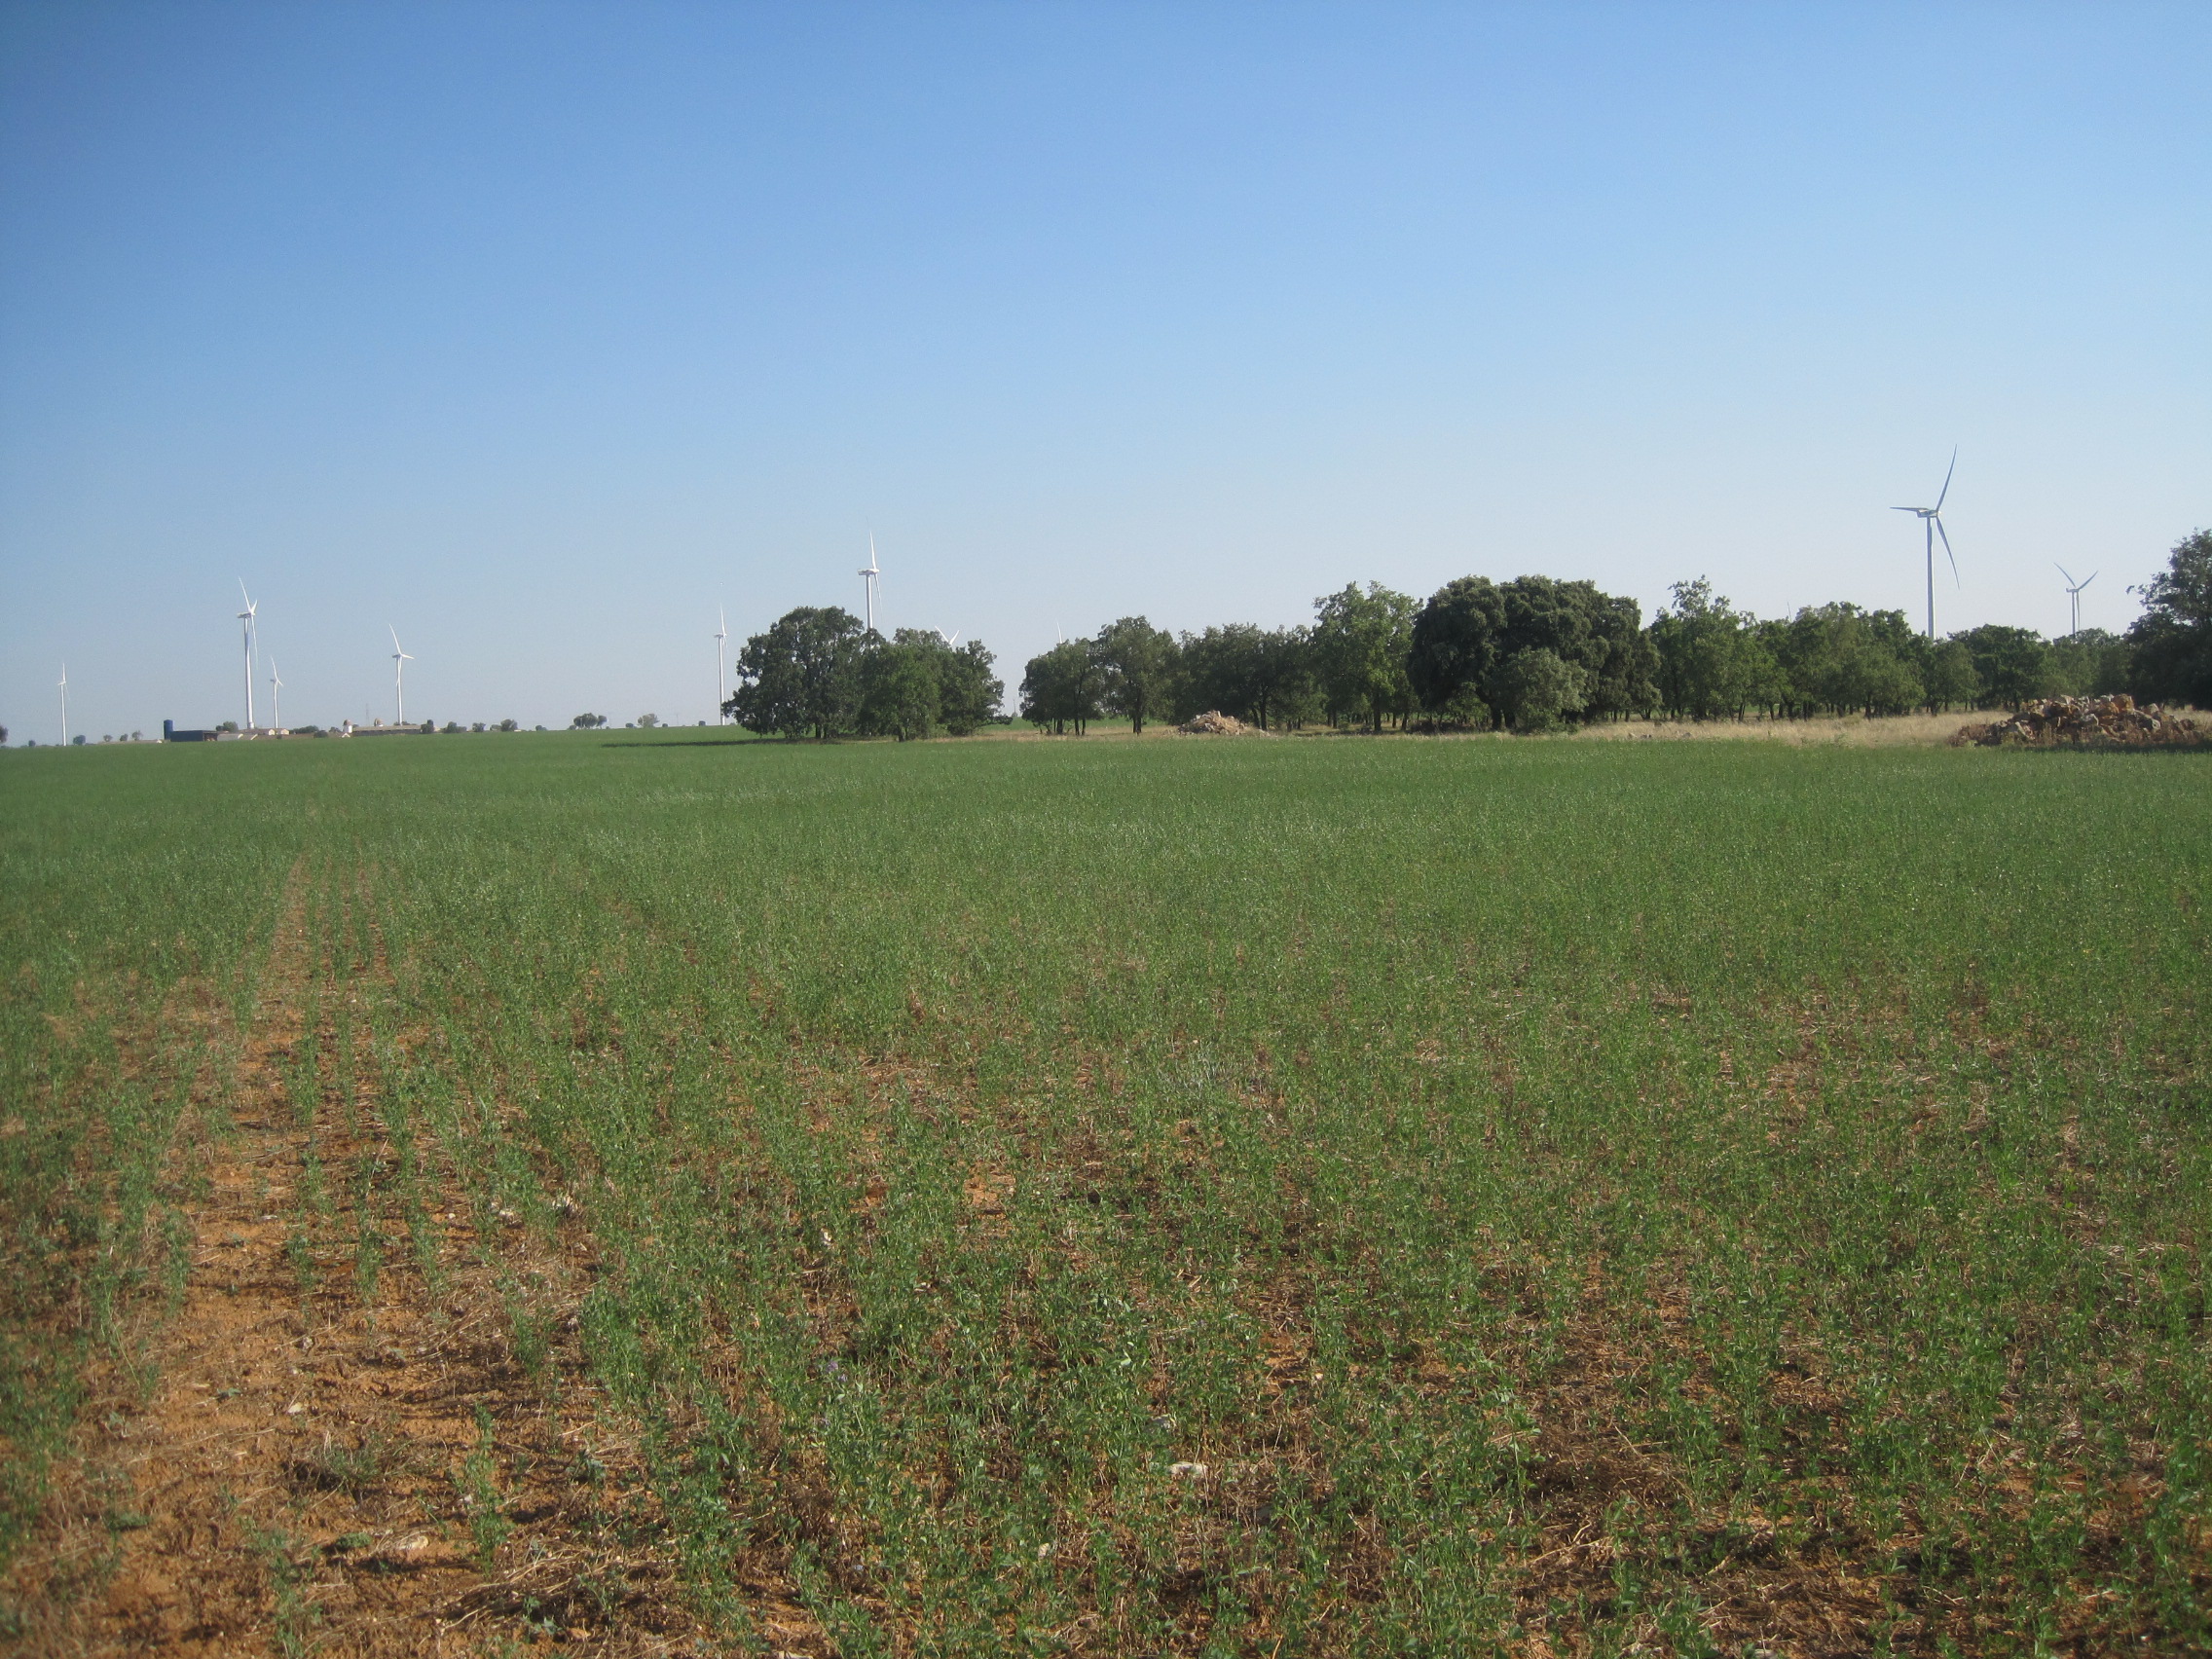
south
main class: Cropland
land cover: Lucerne
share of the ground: > 75 %
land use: Agriculture (excluding fallow land and kitchen gardens)
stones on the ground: 25 - 50 %
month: July
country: ES
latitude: 41.8773
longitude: -4.7611
